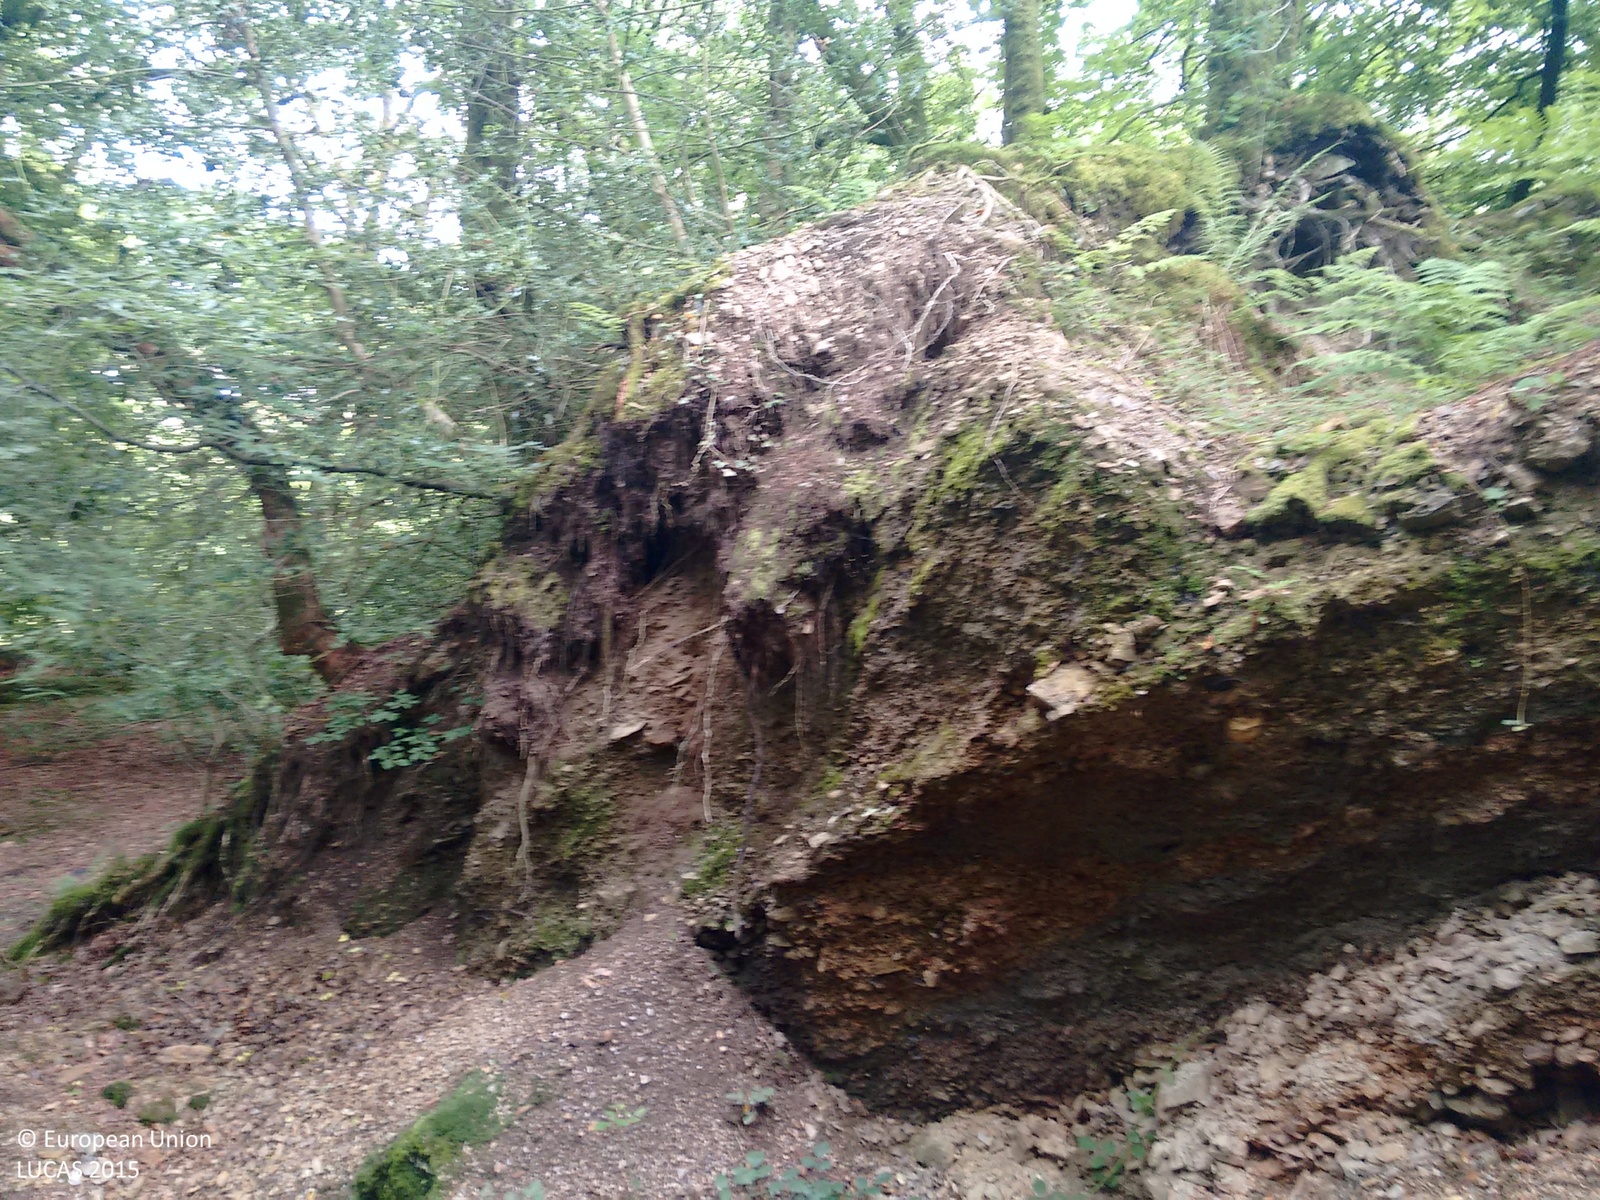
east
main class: Woodland
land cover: Broadleaved woodland
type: acidophilous oak and oak-birch forest
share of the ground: > 75 %
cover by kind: broadleaved forest trees 100 %
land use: Semi-natural and natural areas not in use
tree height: > 5 m
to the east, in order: Broadleaved woodland; Rivers and streams; Fences; Grassland without tree/shrub cover; Electric lines; Grassland without tree/shrub cover; Electric lines; Grassland without tree/shrub cover; Electric lines; Grassland without tree/shrub cover; Fences; Managed hedges; Paved roads, cycling and walking lanes; Rivers and streams; Broadleaved woodland; Fences; Broadleaved woodland; Grassland with sparse tree/shrub cover
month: August
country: GB
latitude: 50.4870
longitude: -4.4082
